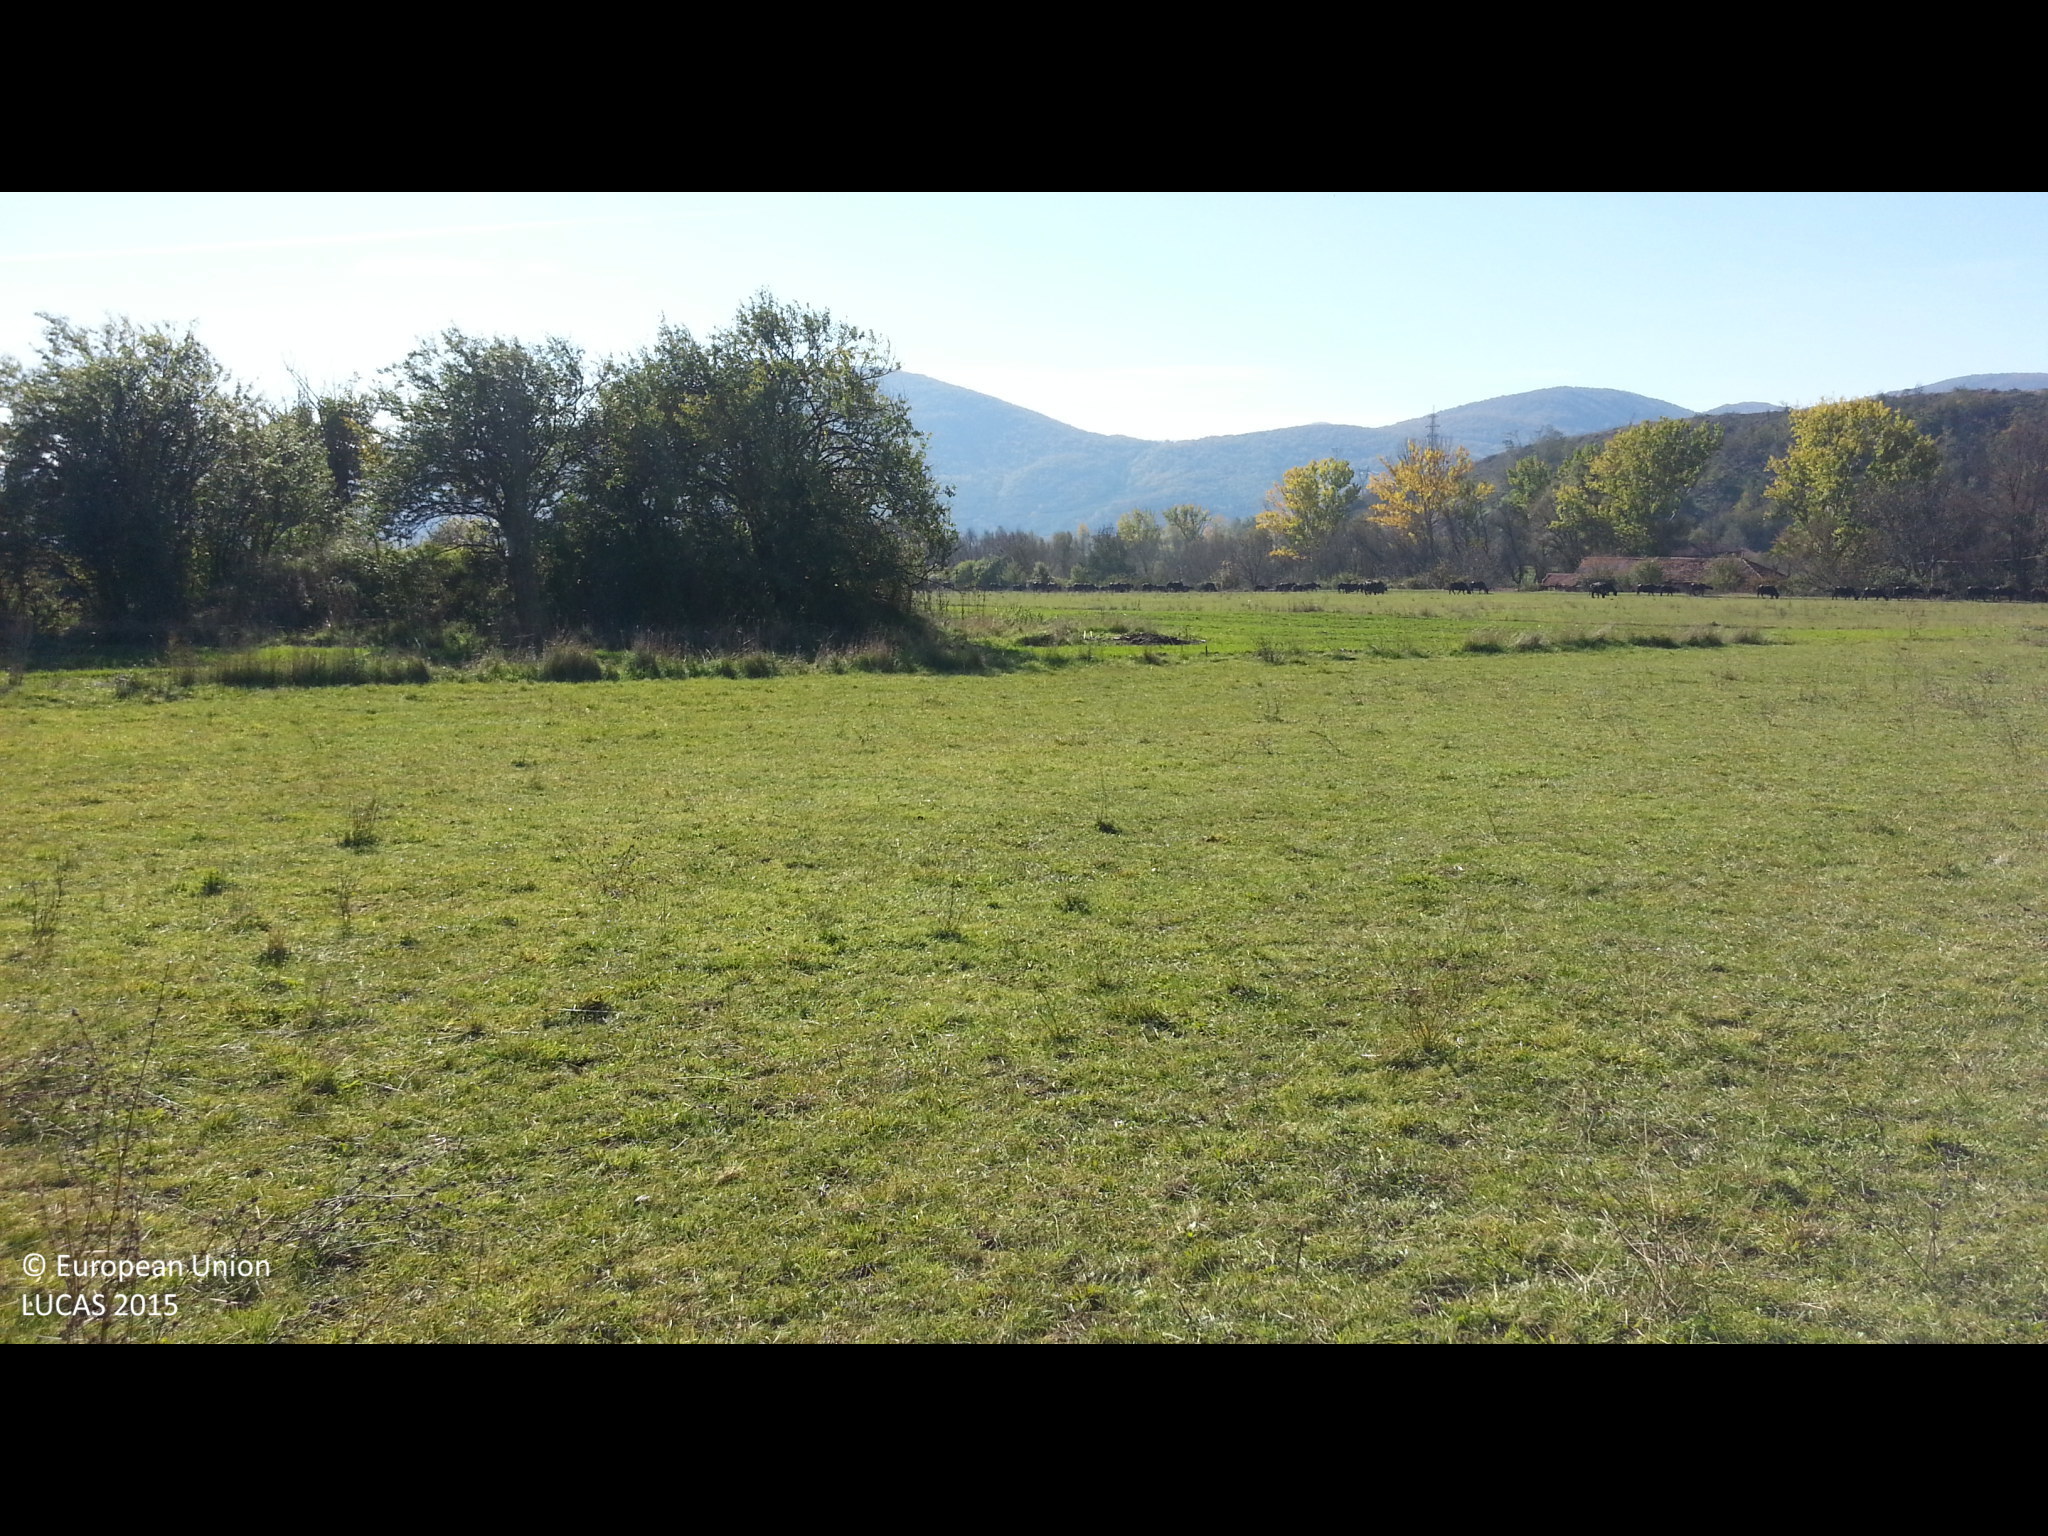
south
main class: Grassland
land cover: Grassland without tree/shrub cover
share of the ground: > 75 %
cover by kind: herbaceous plants 100 %
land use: Agriculture (excluding fallow land and kitchen gardens)
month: November
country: BG
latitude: 42.6835
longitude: 23.9940
